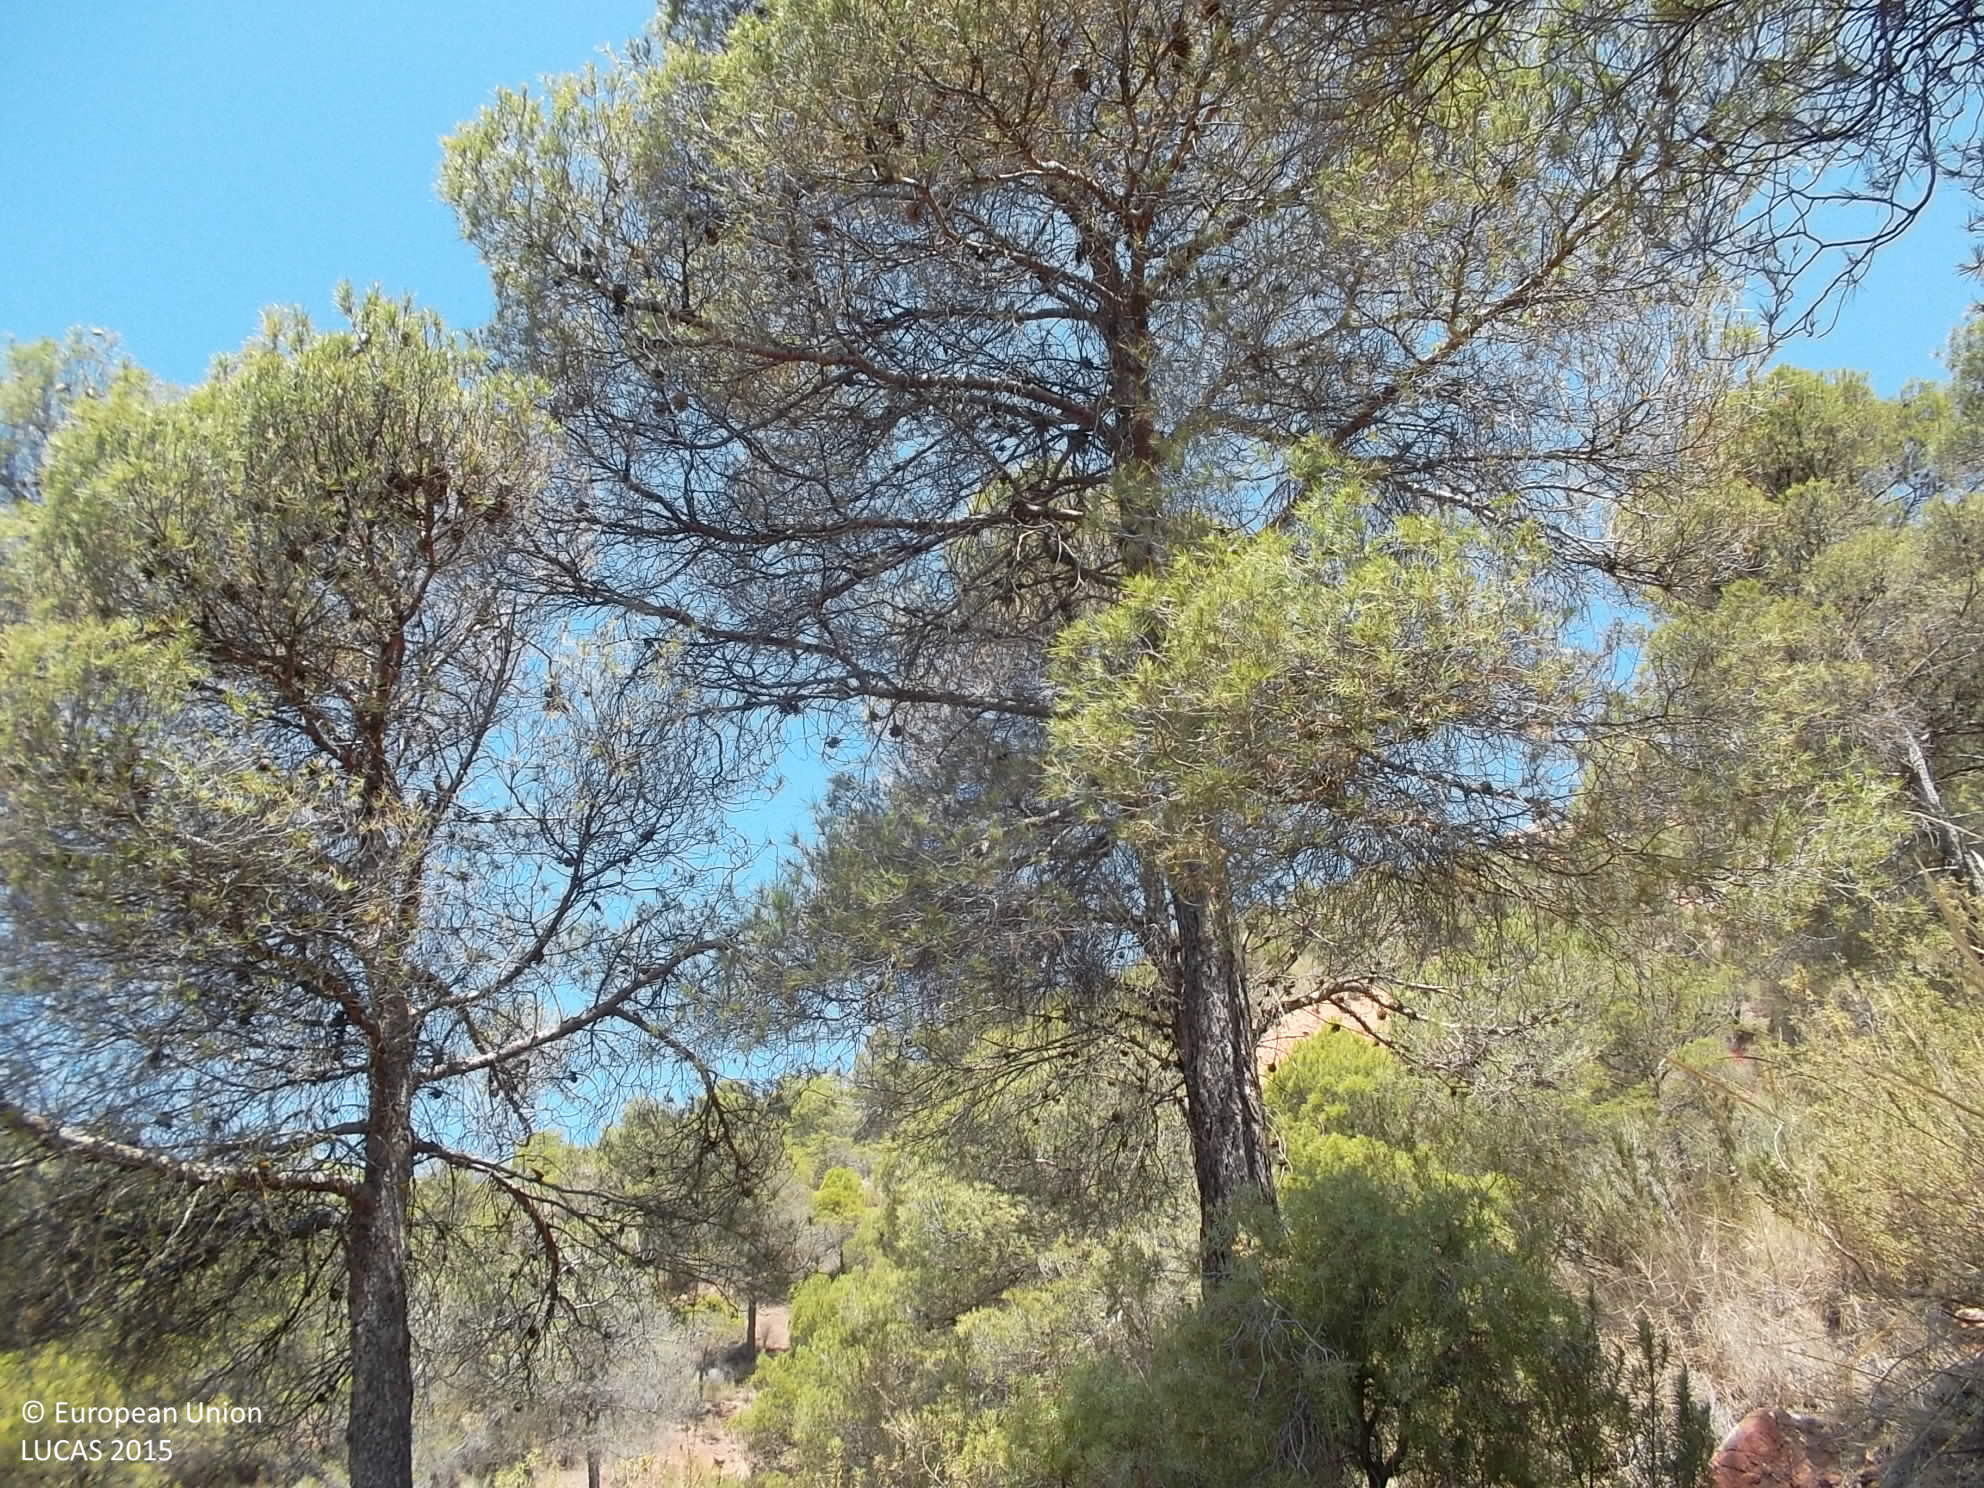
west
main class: Woodland
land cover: Pine dominated coniferous woodland
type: coniferous forest of the mediterranean region
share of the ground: 50 - 75 %
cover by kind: coniferous forest trees 40 %, shrubs 30 %, consolidated bare surface 20 %, herbaceous plants 10 %
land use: Forestry
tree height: > 5 m
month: June
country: ES
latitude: 37.6900
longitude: -3.2967
